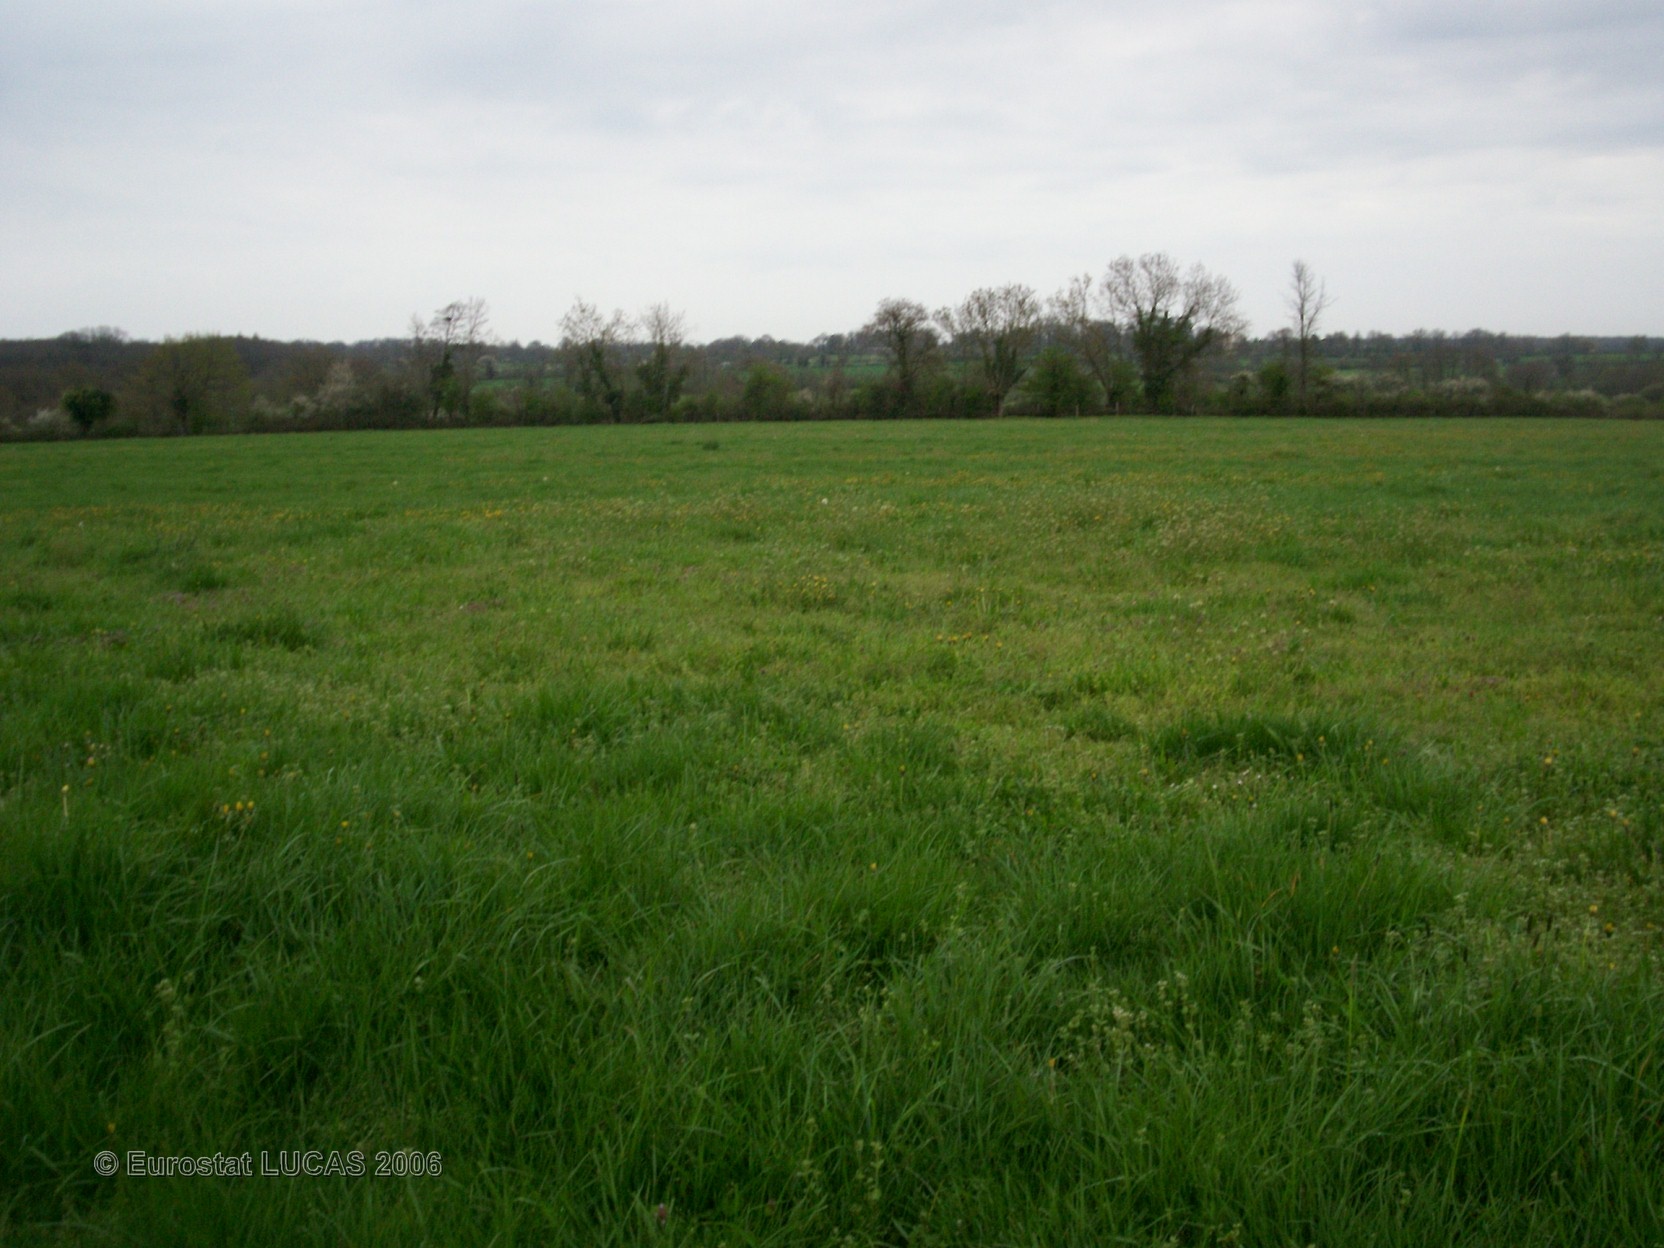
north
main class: Grassland
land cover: Grassland without tree/shrub cover
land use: Agriculture (excluding fallow land and kitchen gardens)
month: April
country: FR
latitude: 46.8438
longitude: -0.3730
